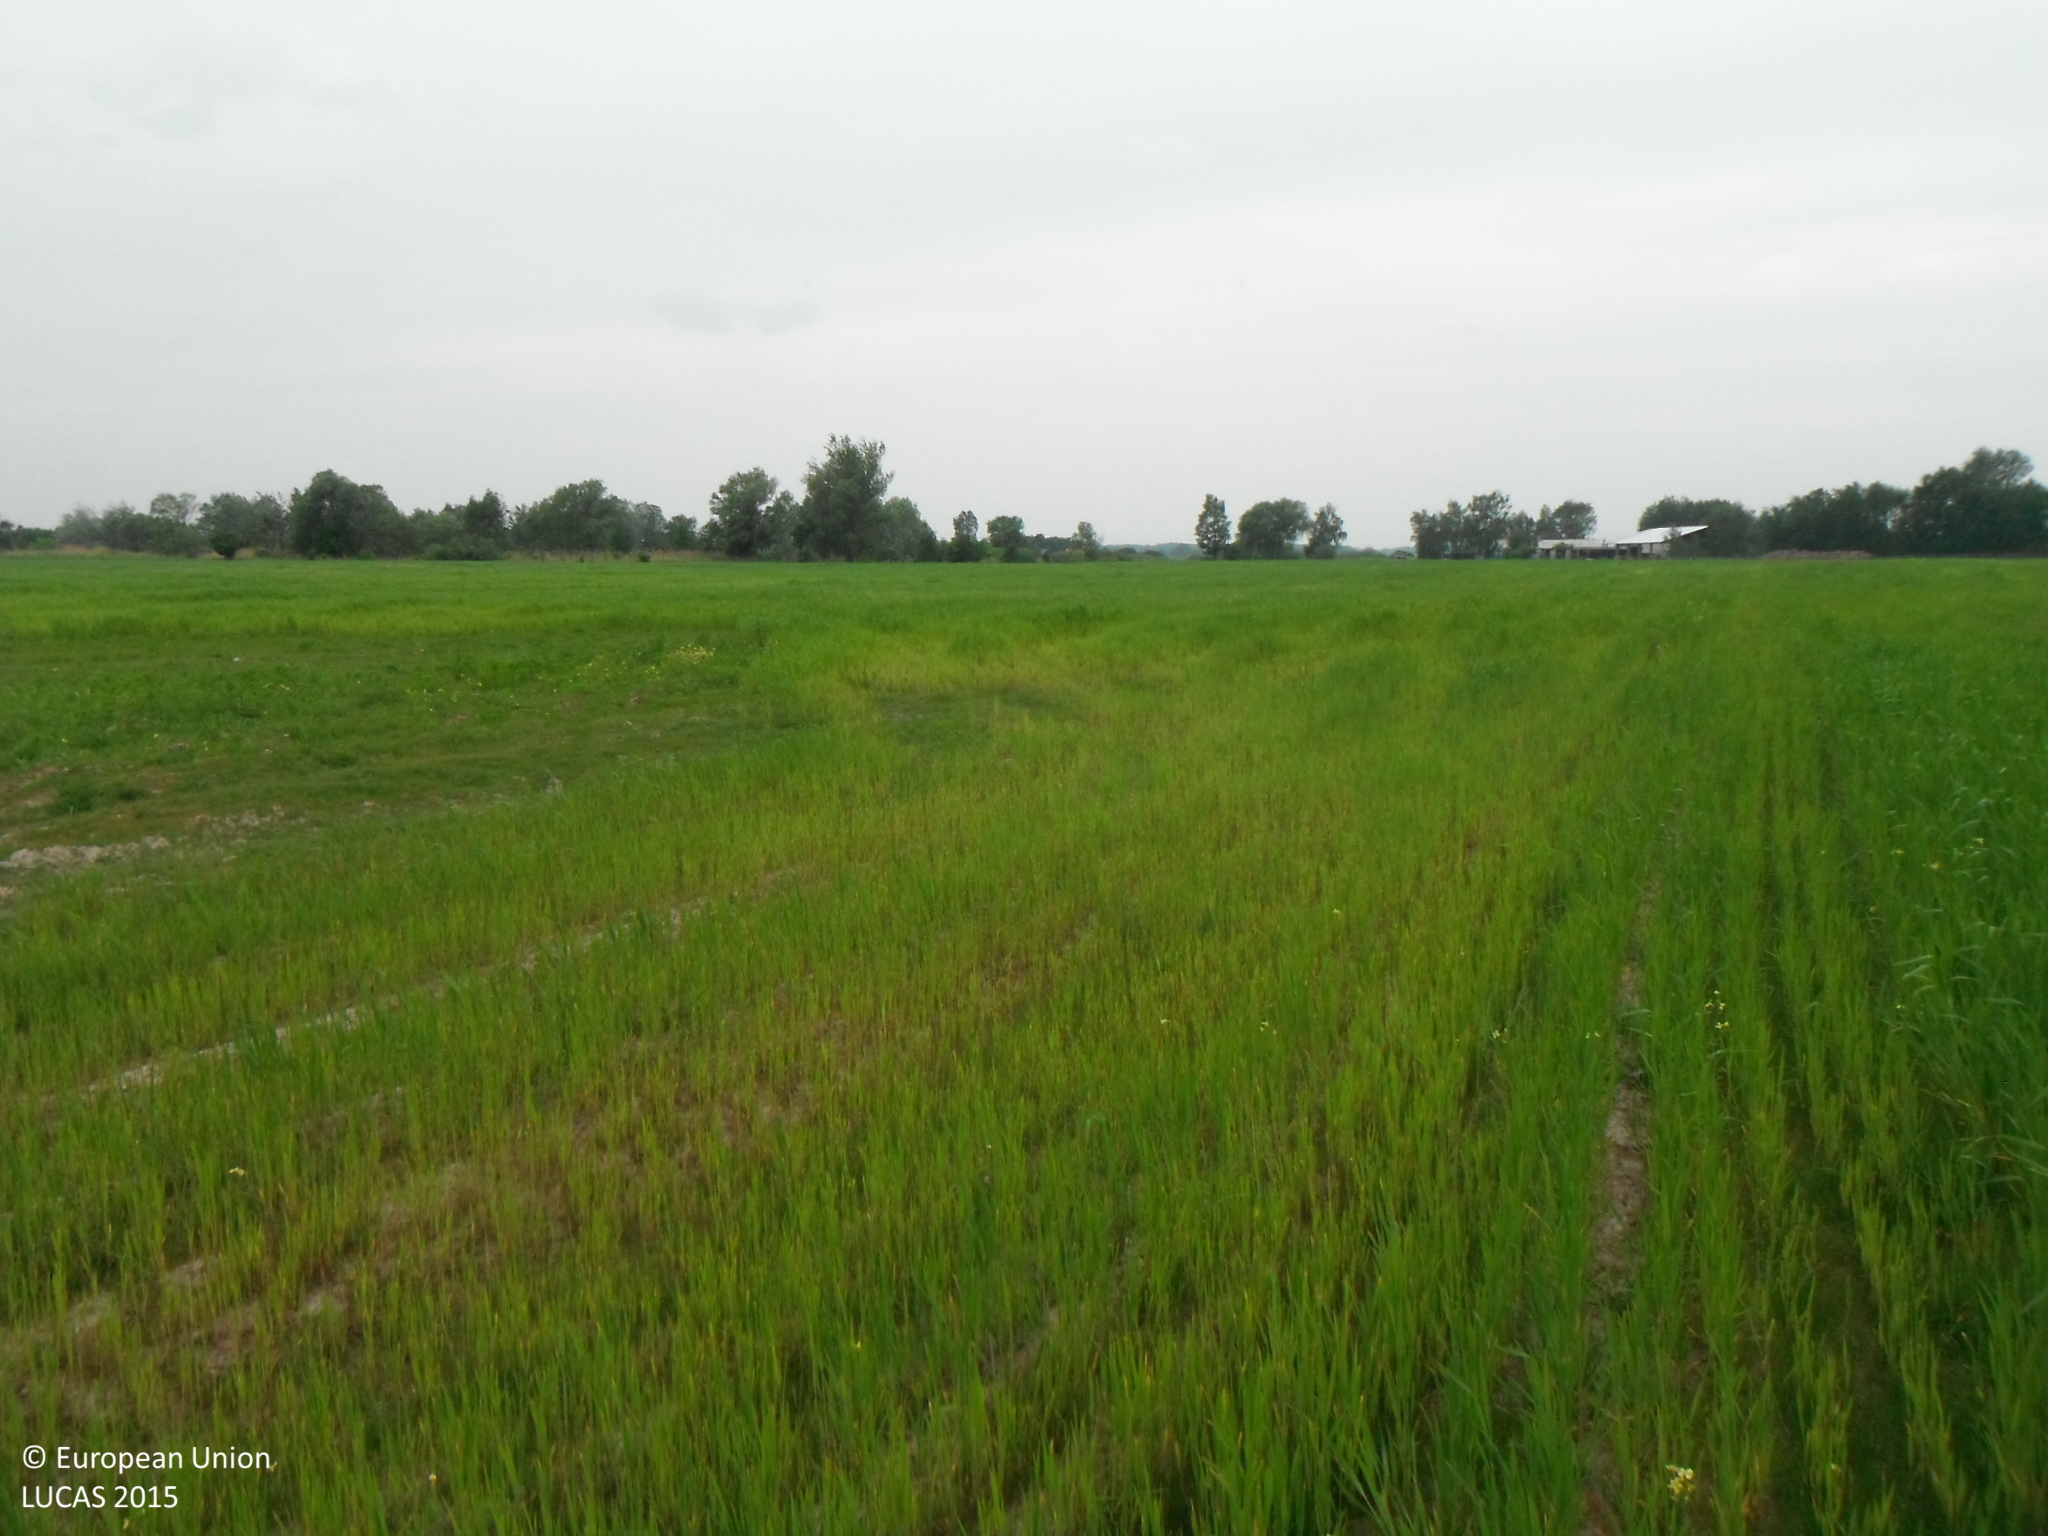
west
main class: Cropland
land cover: Rye
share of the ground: 50 - 75 %
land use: Agriculture (excluding fallow land and kitchen gardens)
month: May
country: SK
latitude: 48.6673
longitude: 17.0286
